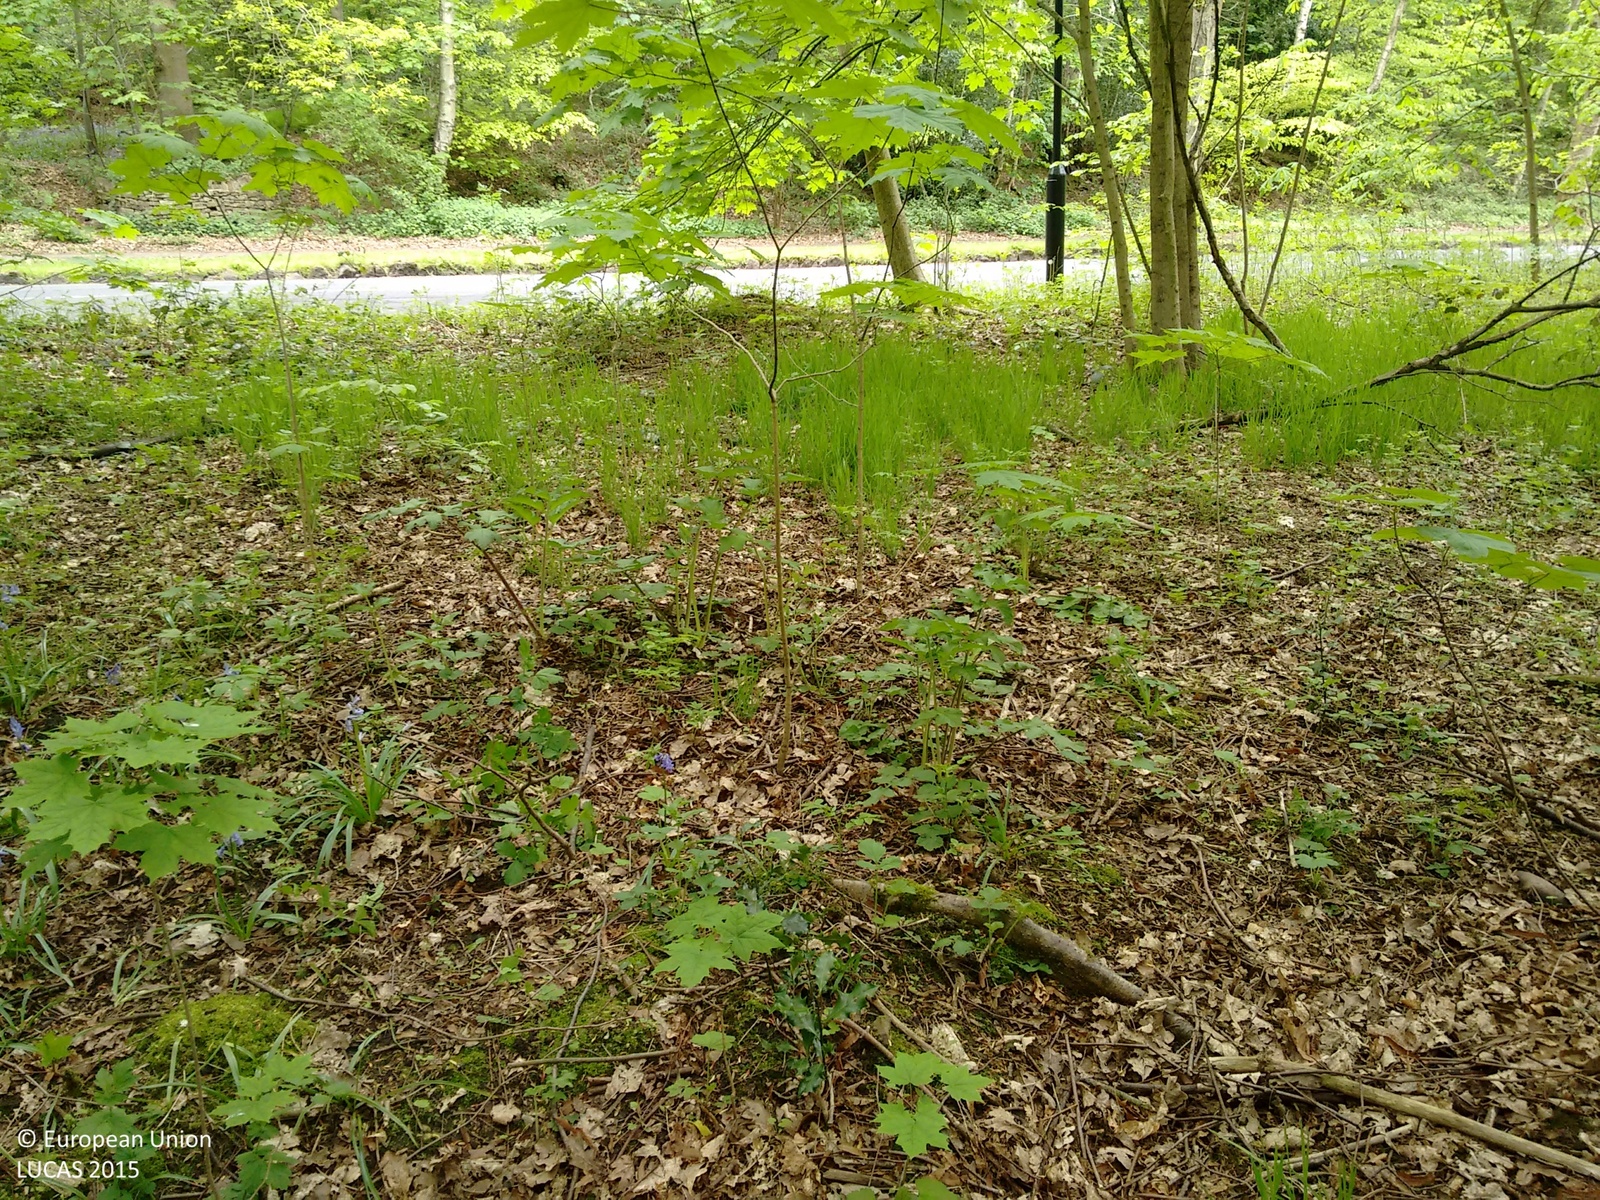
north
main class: Woodland
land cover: Broadleaved woodland
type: mesophytic deciduous forest
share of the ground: > 75 %
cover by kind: broadleaved forest trees 100 %
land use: Semi-natural and natural areas not in use
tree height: > 5 m
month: May
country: GB
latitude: 53.3415
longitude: -1.5103
